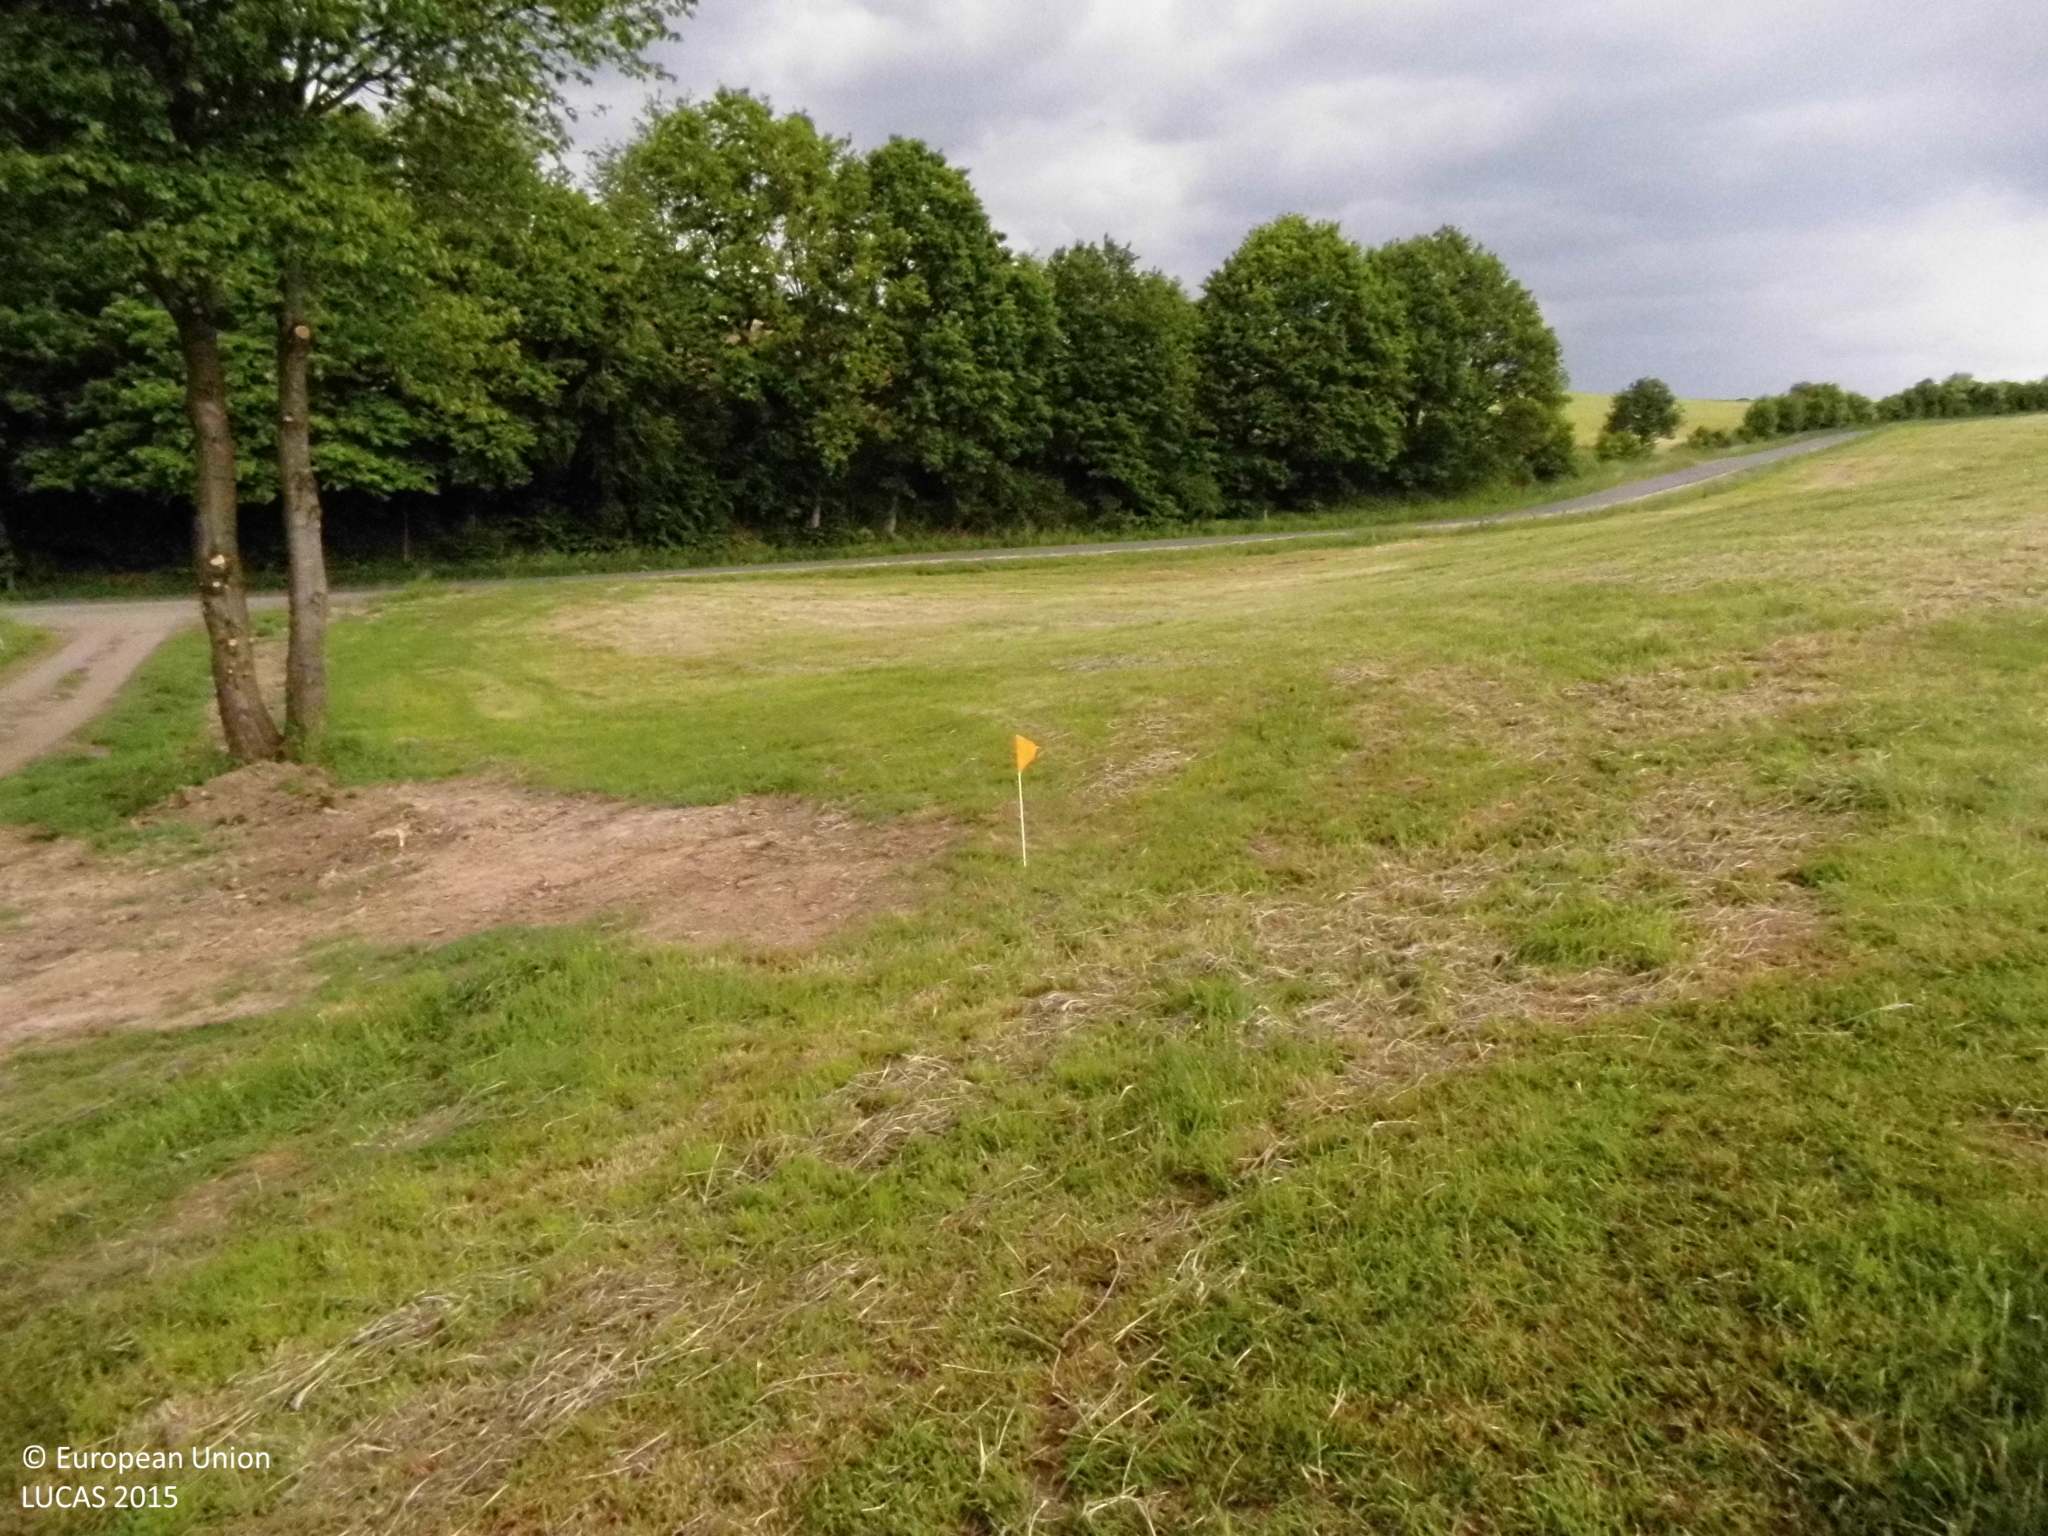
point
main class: Grassland
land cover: Grassland with sparse tree/shrub cover
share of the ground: > 75 %
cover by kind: herbaceous plants 90 %, broadleaved forest trees 5 %, unconsolidated bare surface 5 %
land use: Agriculture (excluding fallow land and kitchen gardens)
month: May
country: DE
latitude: 50.8934
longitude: 7.4554
